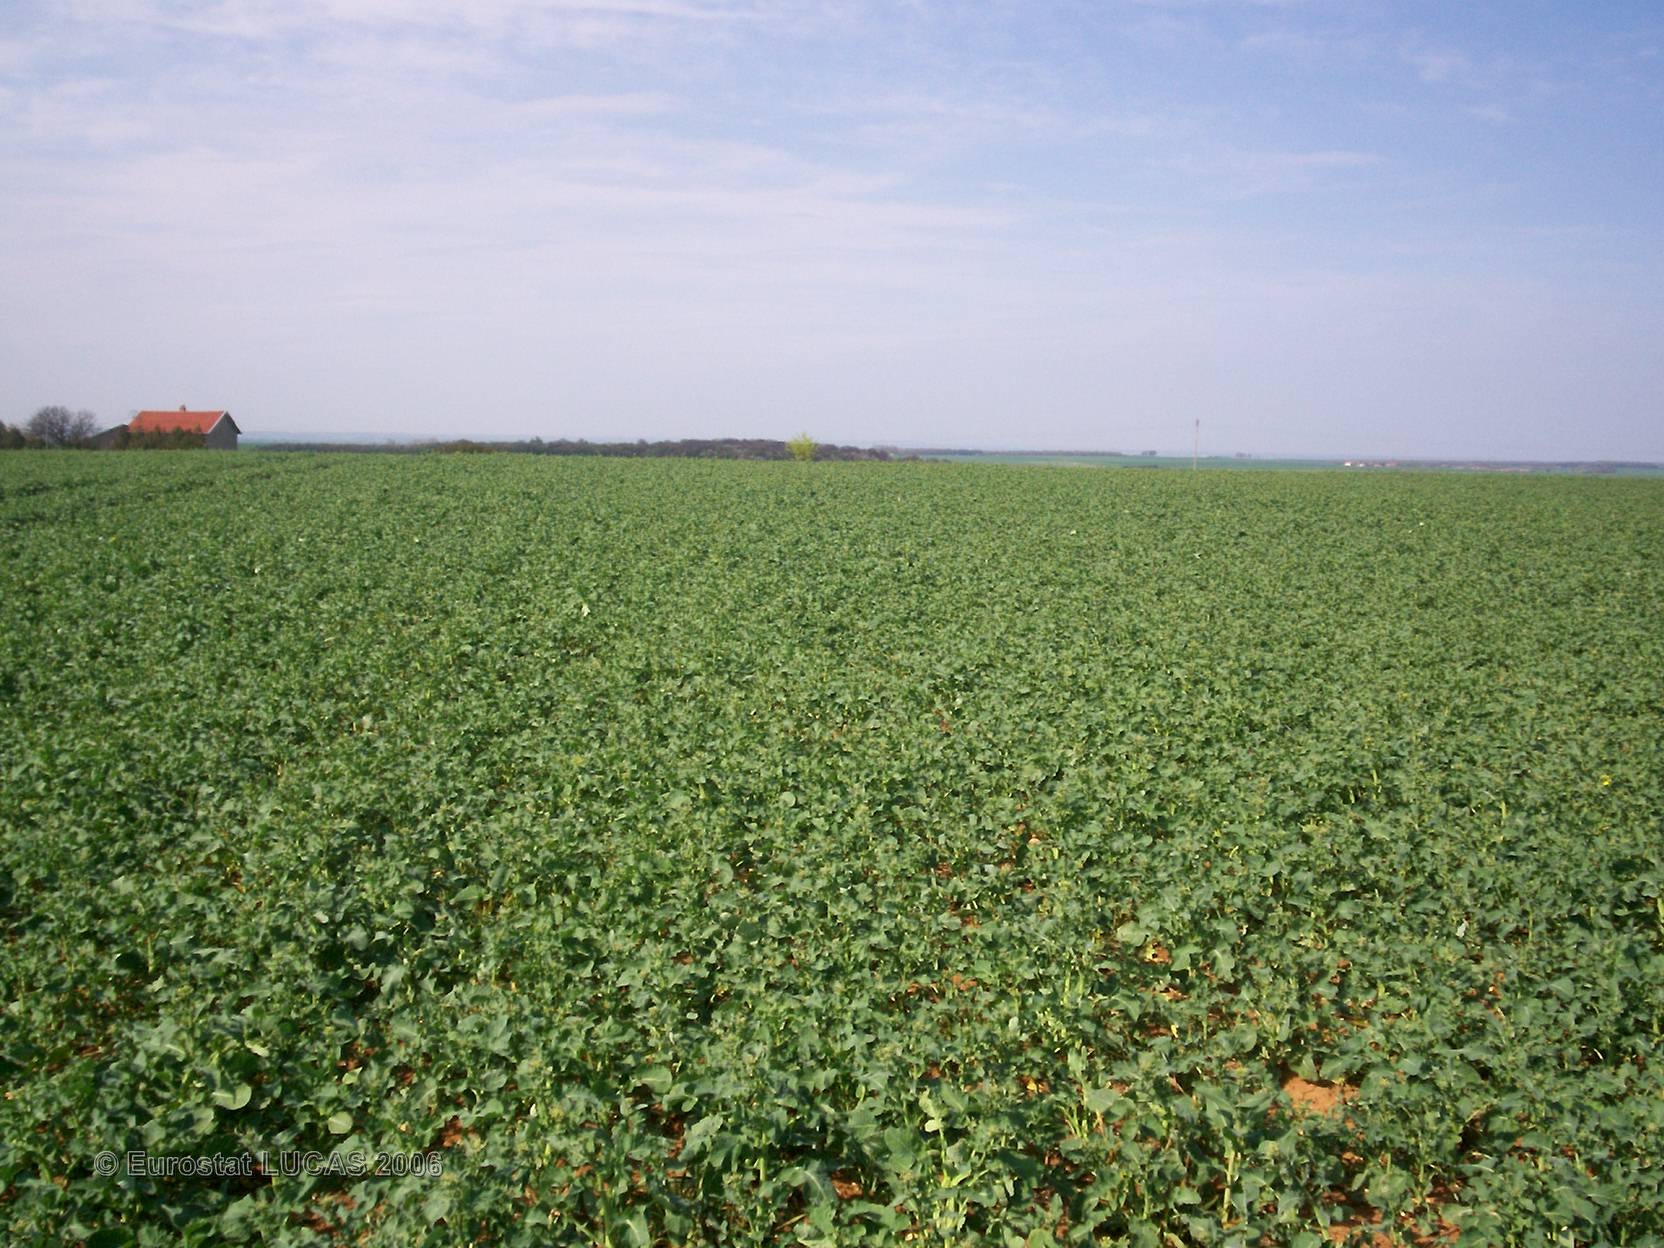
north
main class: Cropland
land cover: Rape and turnip rape
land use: Agriculture (excluding fallow land and kitchen gardens)
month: April
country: FR
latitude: 49.0494
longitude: 5.9358
